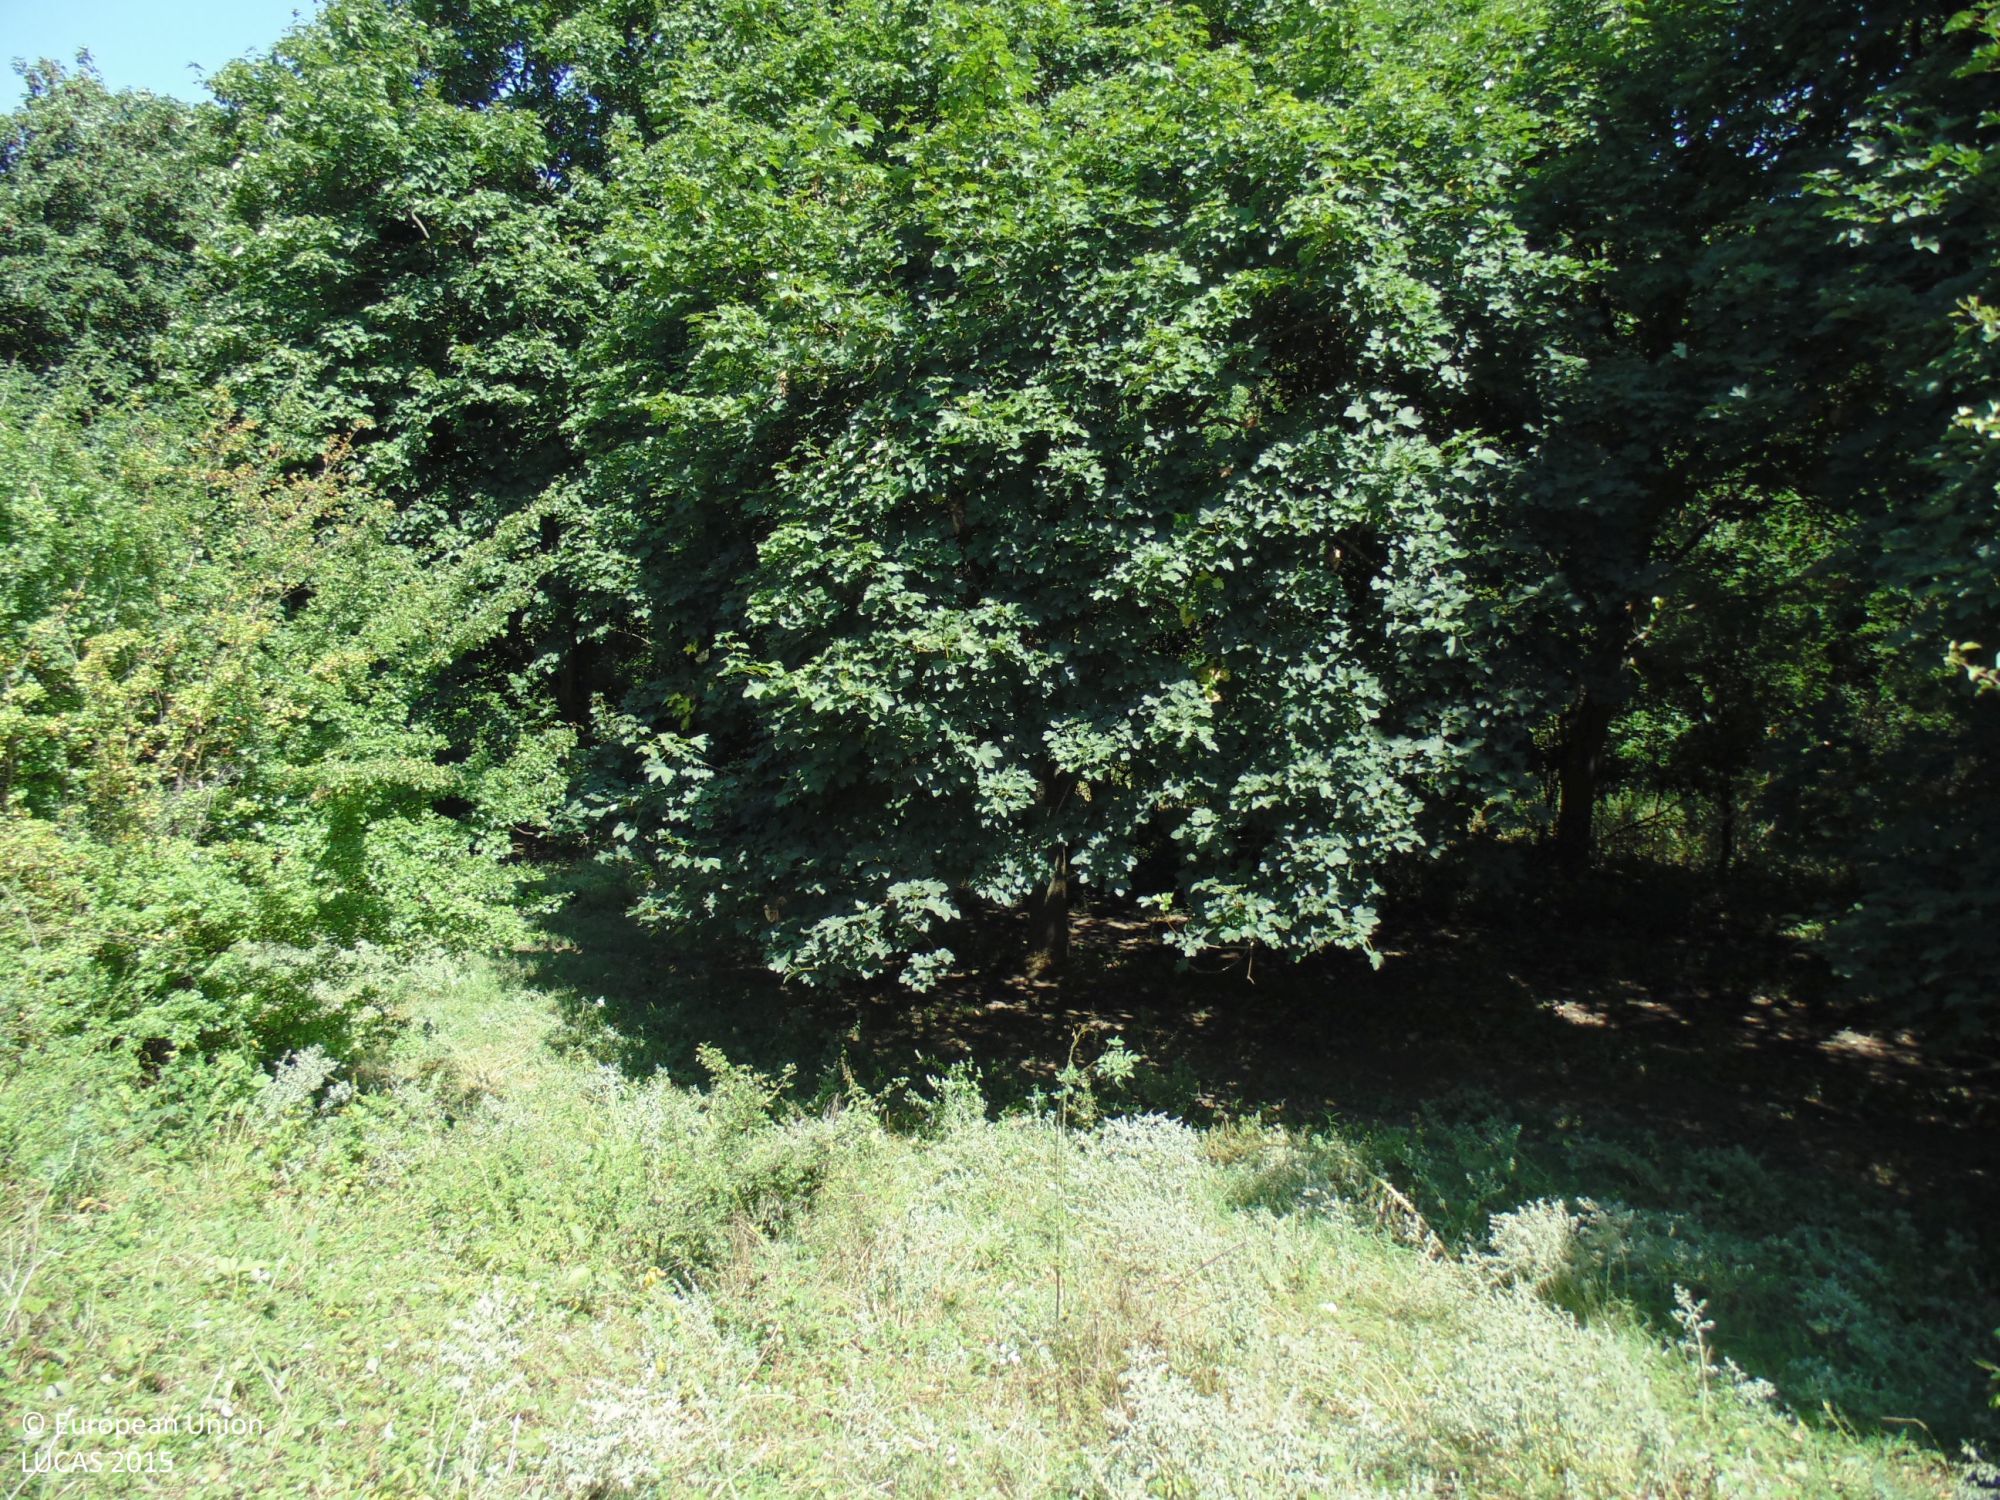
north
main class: Woodland
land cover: Broadleaved woodland
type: mesophytic deciduous forest
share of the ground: 25 - 50 %
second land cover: Grassland without tree/shrub cover
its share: > 75 %
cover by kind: herbaceous plants 70 %, broadleaved forest trees 25 %, shrubs 5 %
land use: Forestry
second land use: Agriculture (excluding fallow land and kitchen gardens)
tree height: < 5 m
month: August
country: BG
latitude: 43.6397
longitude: 28.1383
